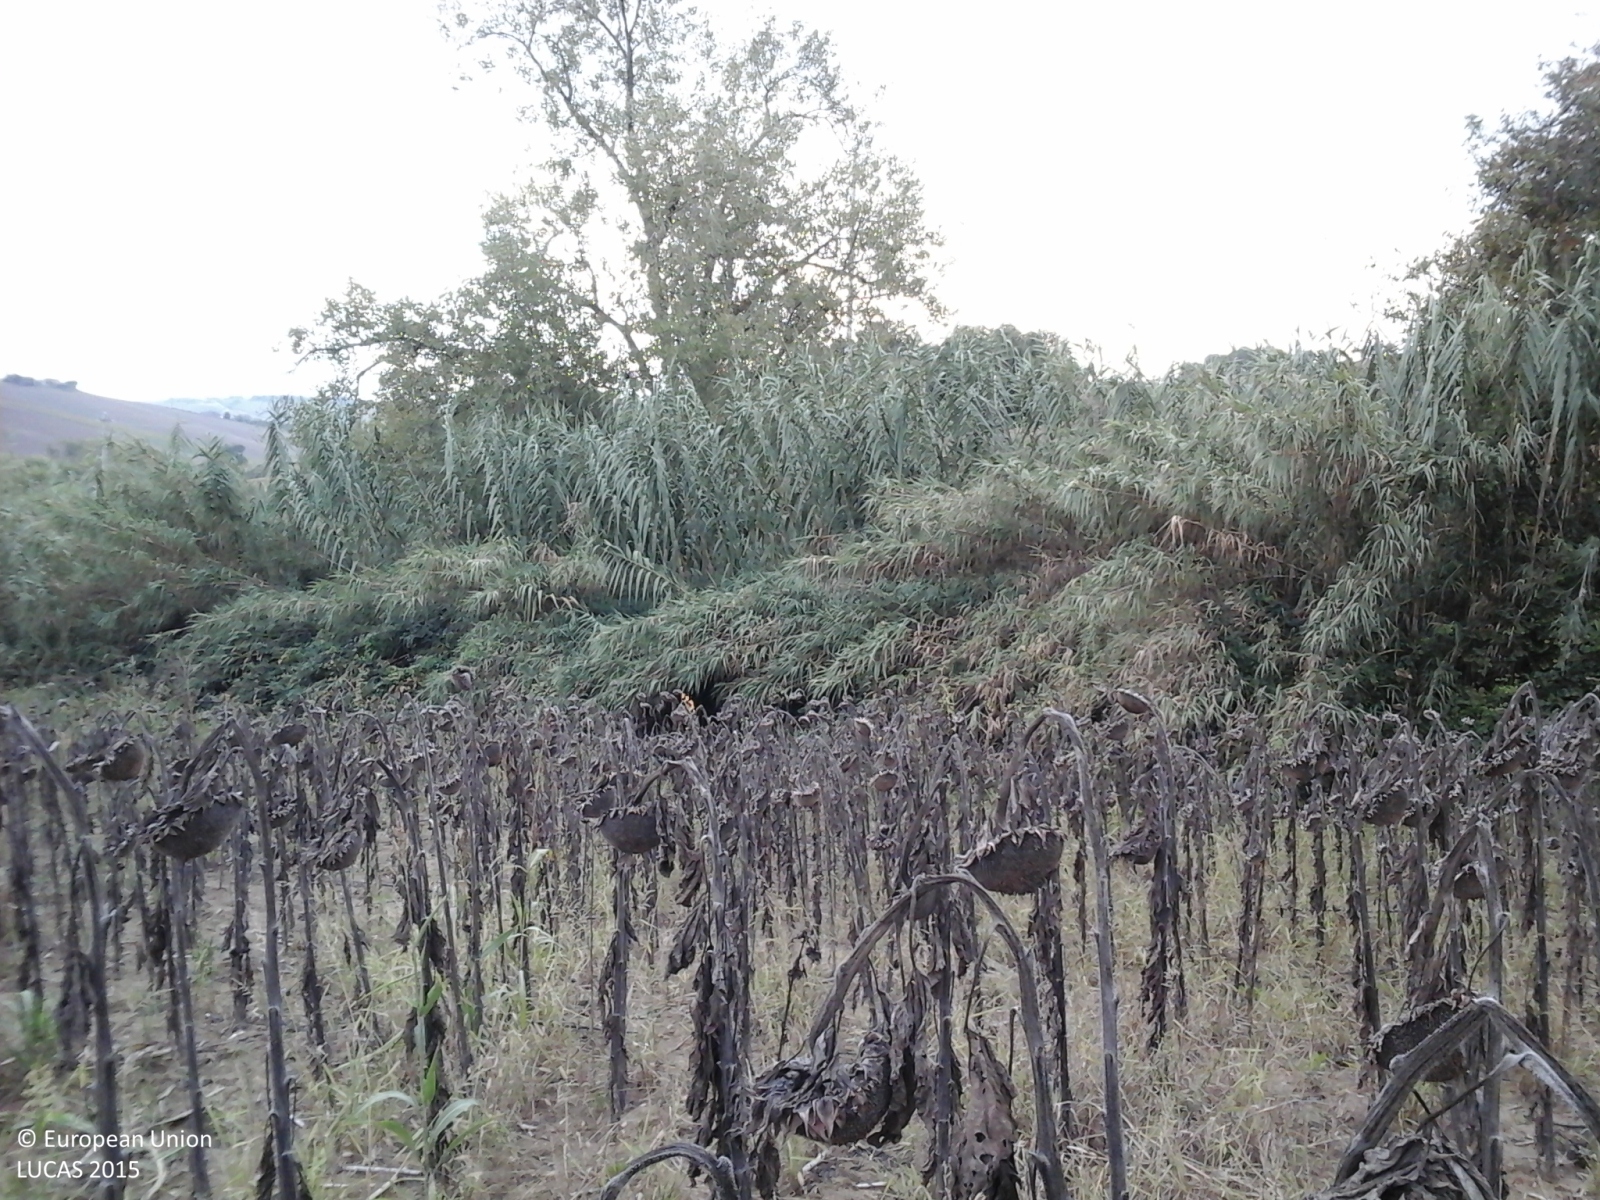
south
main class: Cropland
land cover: Sunflower
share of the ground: > 75 %
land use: Agriculture (excluding fallow land and kitchen gardens)
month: October
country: IT
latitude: 43.5799
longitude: 13.1749
